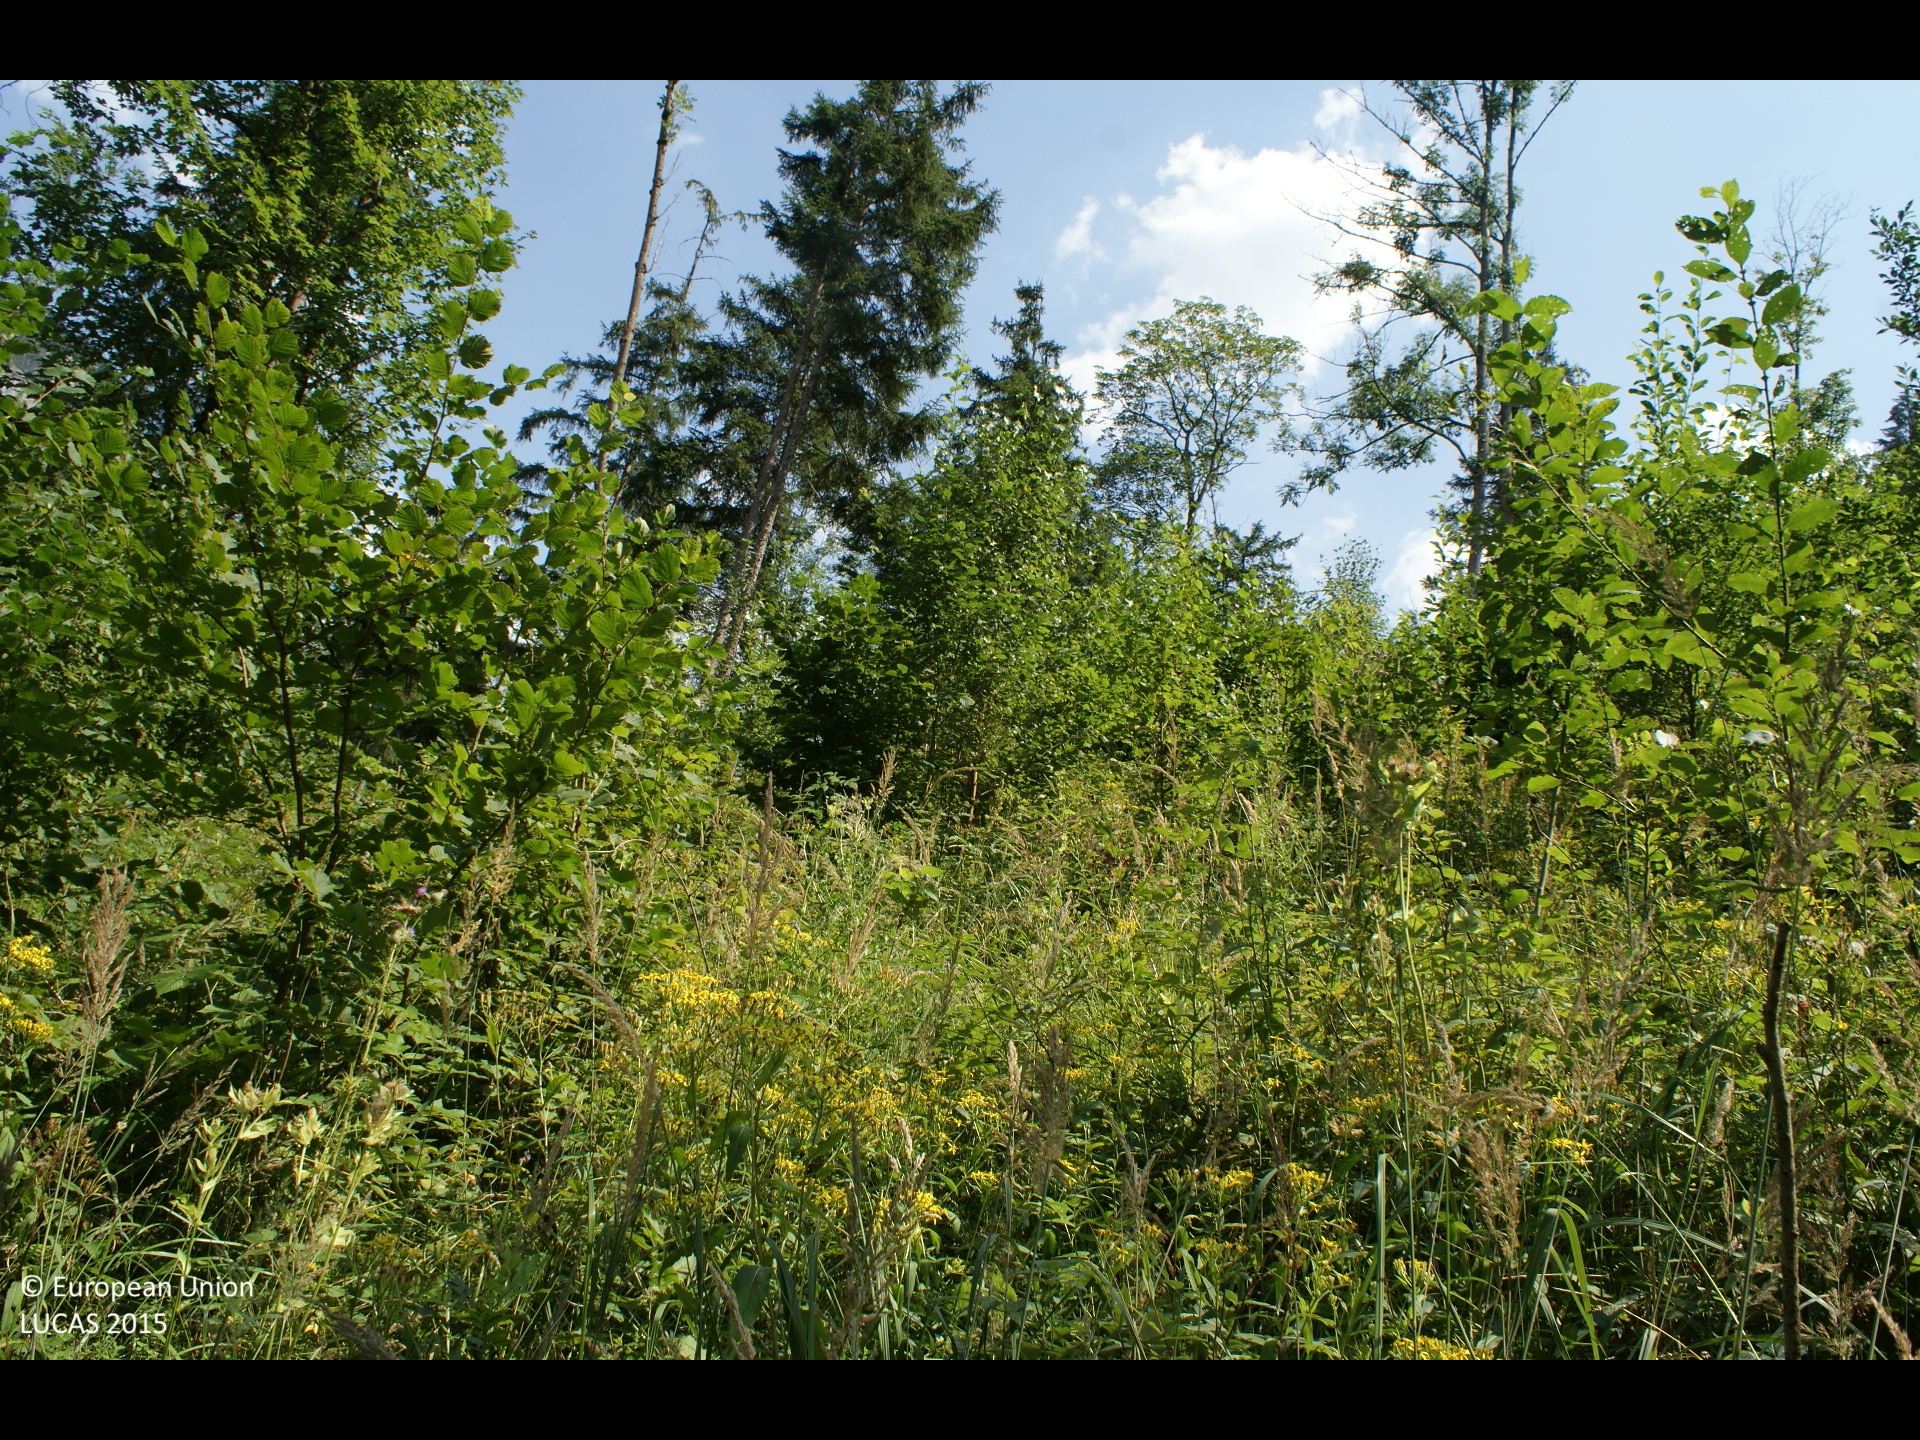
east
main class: Shrubland
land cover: Shrubland with sparse tree cover
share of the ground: > 75 %
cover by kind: shrubs 75 %, herbaceous plants 20 %, broadleaved forest trees 5 %
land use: Forestry
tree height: < 5 m
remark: Clear cut
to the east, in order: Shrubland with sparse tree cover; Spruce dominated coniferous woodland; Tracks; Spruce dominated mixed woodland; Grassland without tree/shrub cover; Broadleaved woodland; Rivers and streams; Shrubland without tree cover; Grassland without tree/shrub cover; Broadleaved woodland
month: August
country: AT
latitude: 47.7151
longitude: 15.3462
